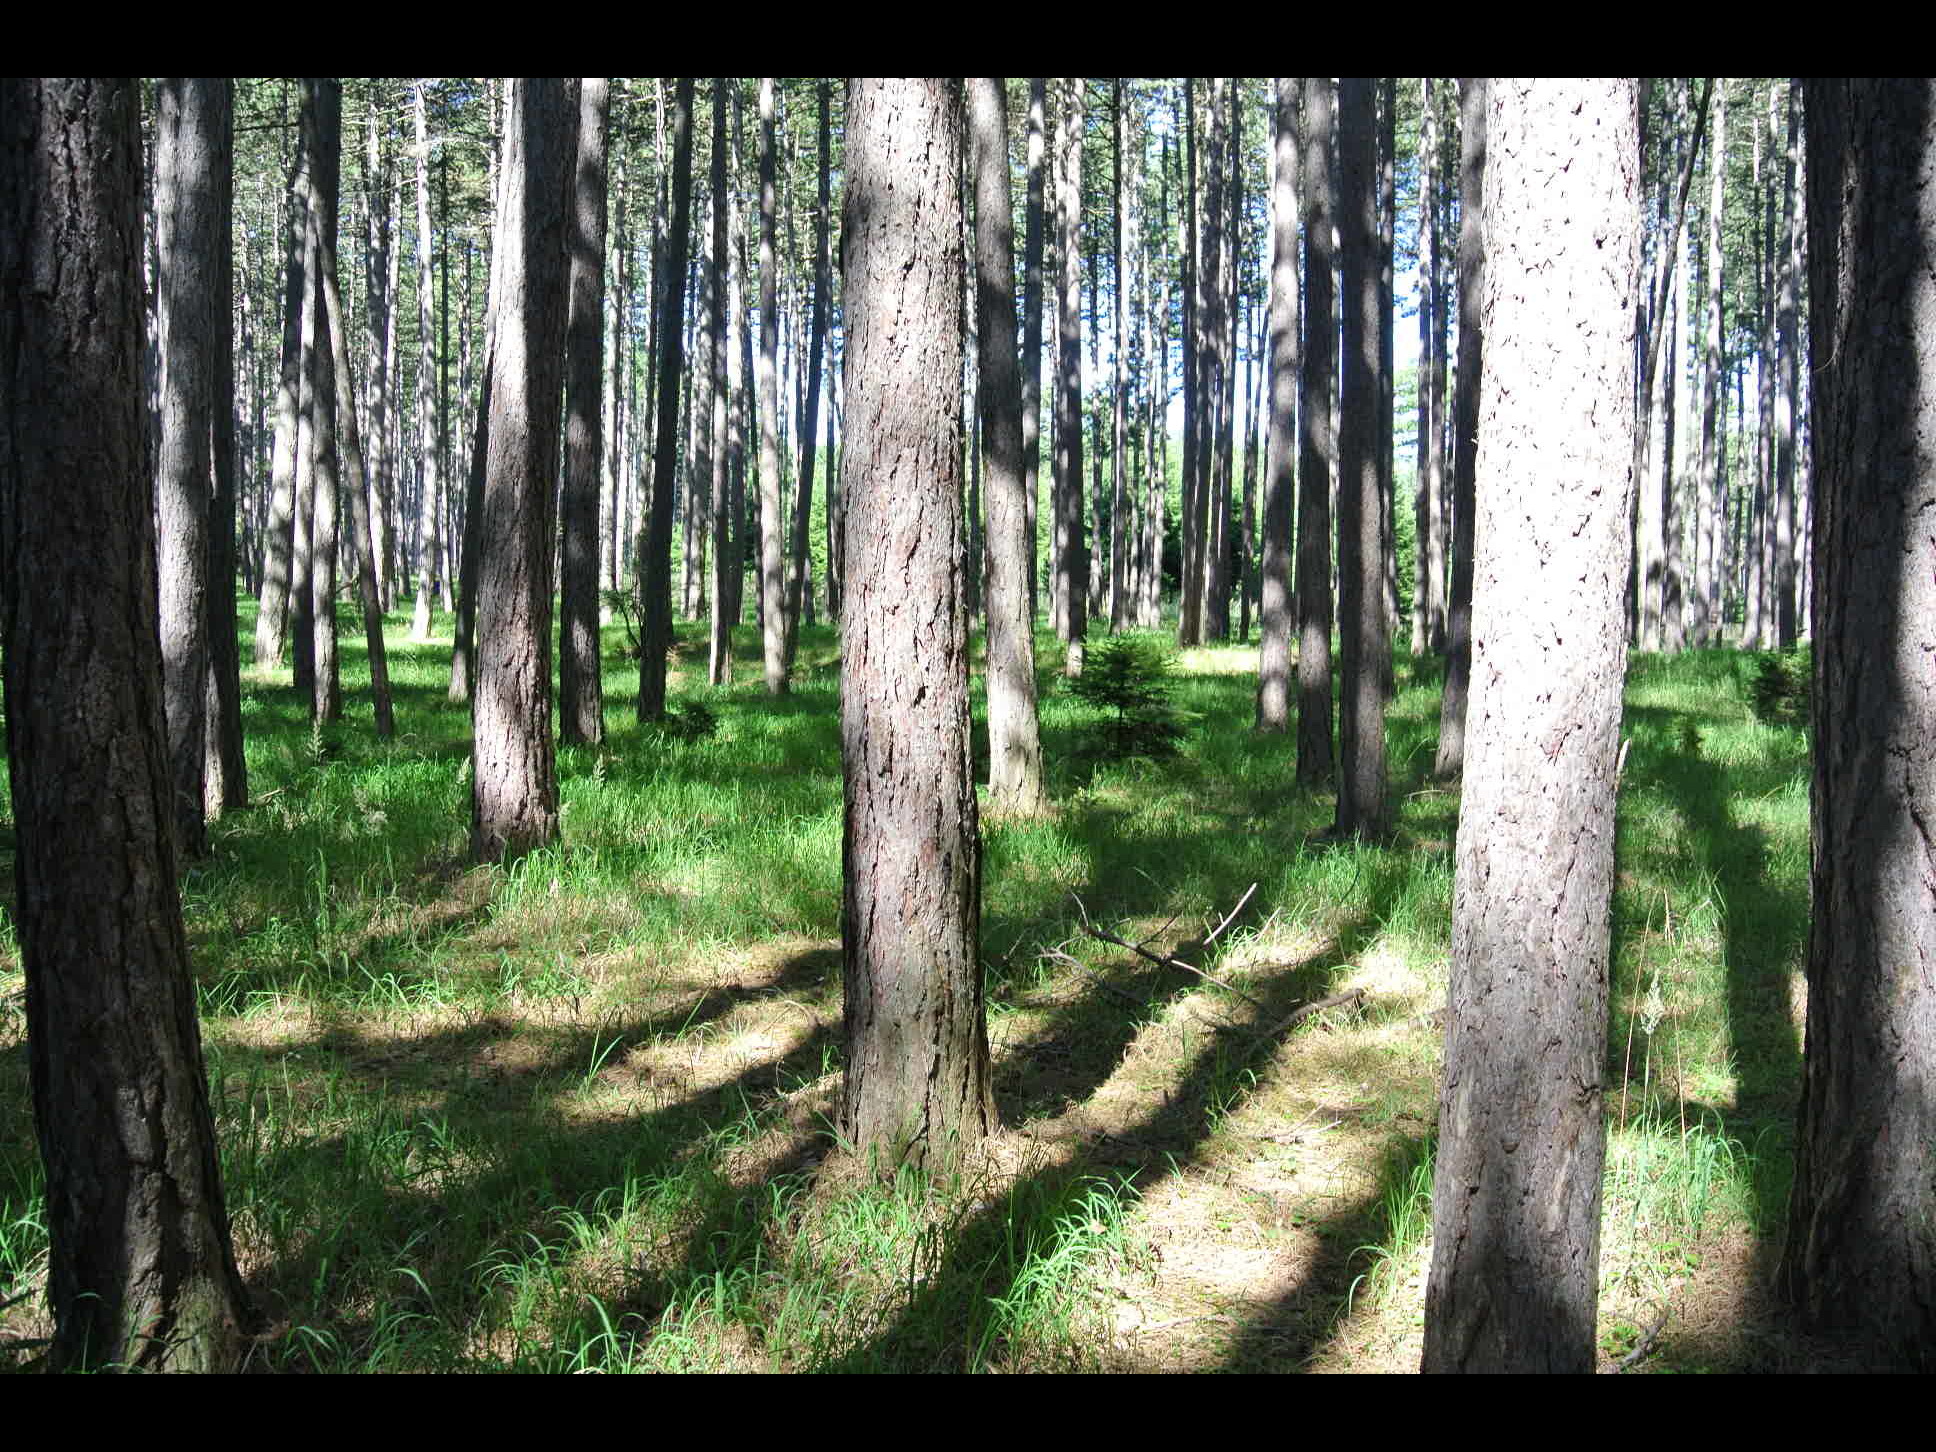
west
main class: Woodland
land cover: Pine dominated coniferous woodland
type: alpine coniferous forest
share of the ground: > 75 %
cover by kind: coniferous forest trees 100 %
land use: Forestry
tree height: > 5 m
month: July
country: AT
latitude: 47.7494
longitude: 16.0719
